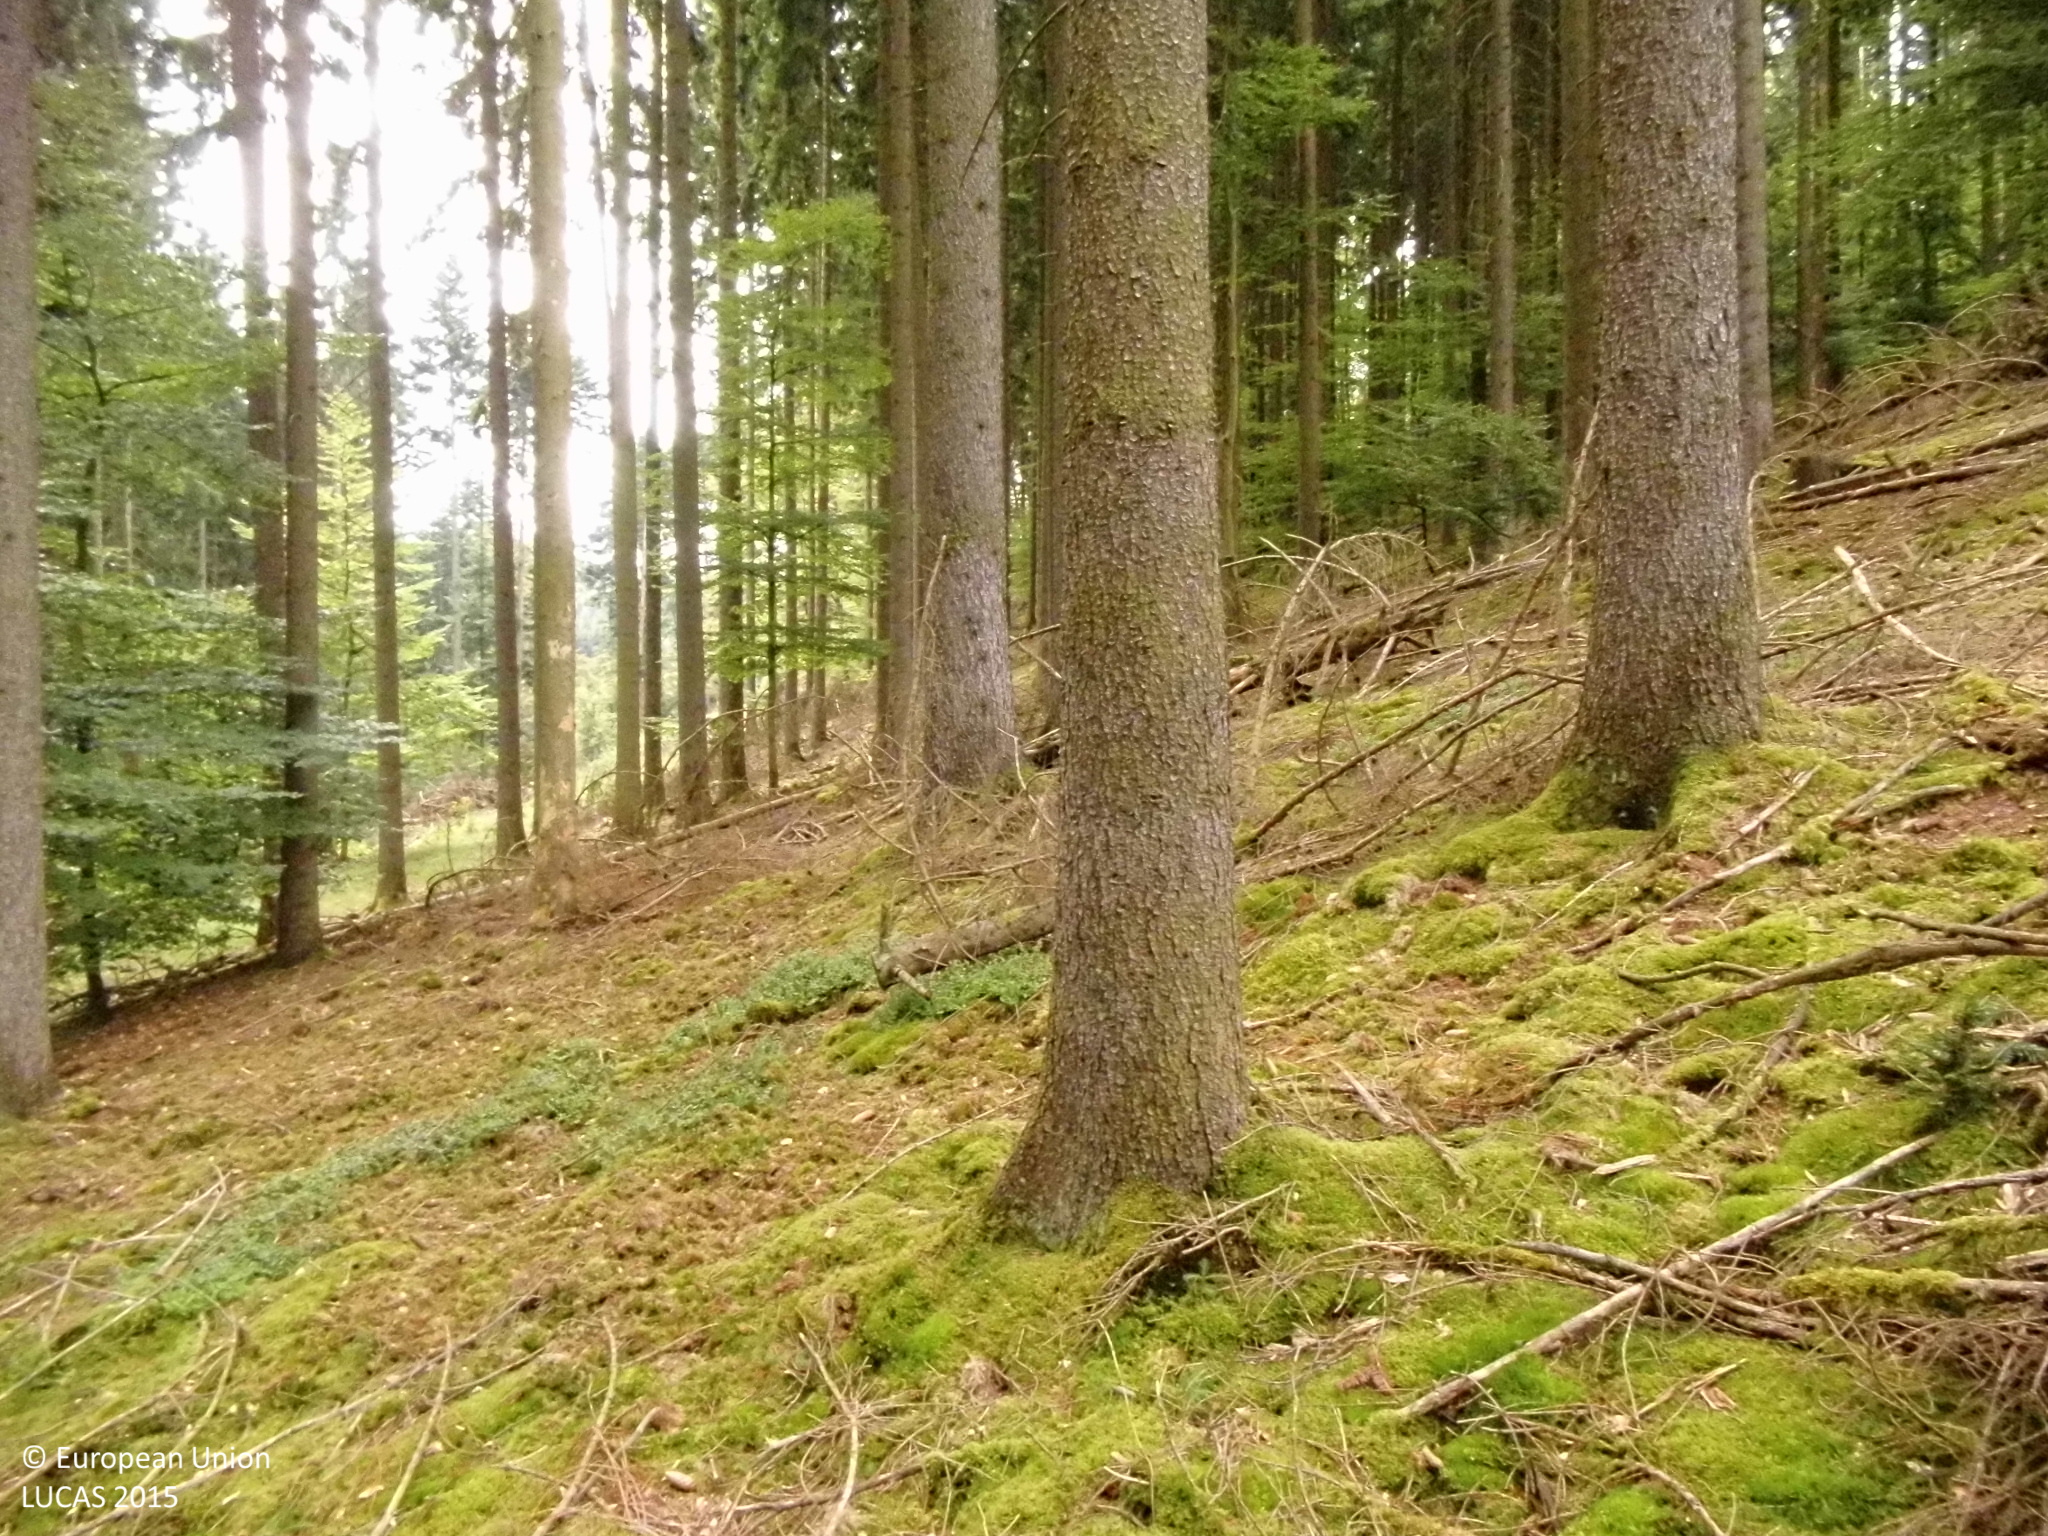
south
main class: Woodland
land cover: Spruce dominated coniferous woodland
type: hemiboreal forest and nemoral coniferous forest and mixed broadleaved-coniferous forest
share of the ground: > 75 %
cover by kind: coniferous forest trees 65 %, broadleaved forest trees 15 %, lichens and mosses 10 %, shrubs 5 %, unconsolidated bare surface 5 %
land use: Forestry
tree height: > 5 m
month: August
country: DE
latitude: 50.9847
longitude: 8.5901
